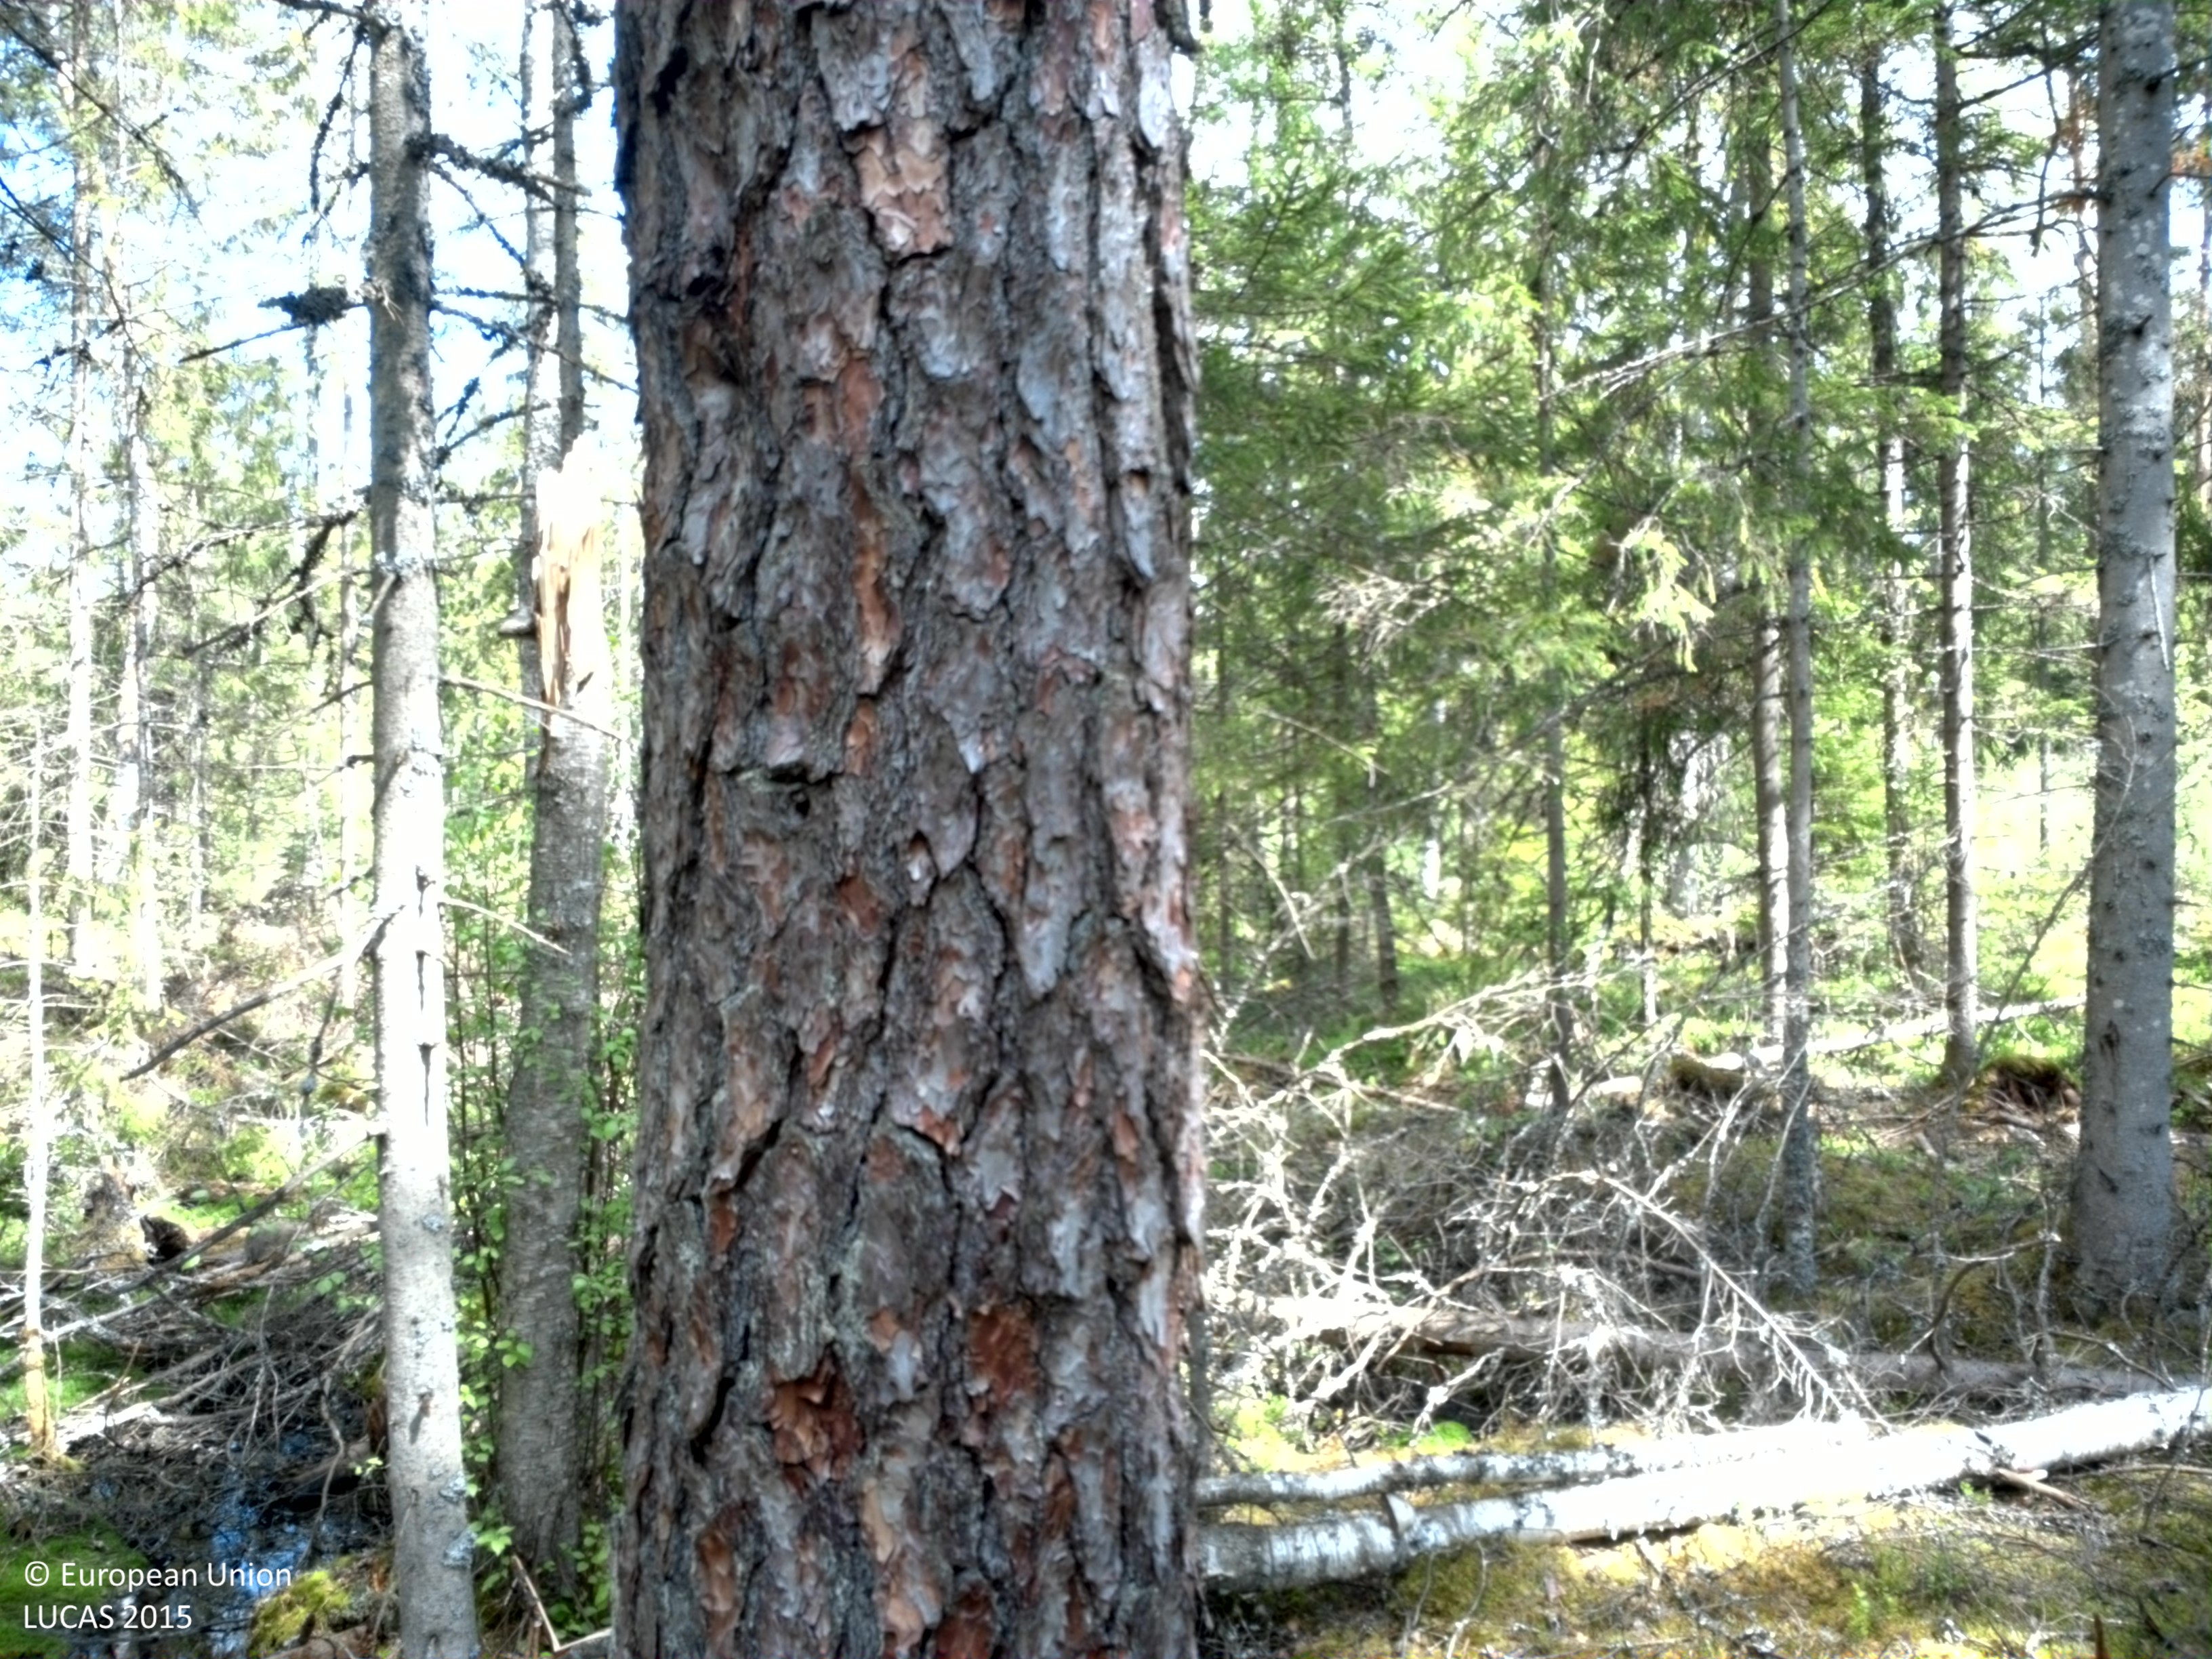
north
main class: Woodland
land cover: Pine dominated coniferous woodland
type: boreal forest
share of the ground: > 75 %
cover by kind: coniferous forest trees 60 %, broadleaved forest trees 20 %, shrubs 10 %, lichens and mosses 10 %
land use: Forestry
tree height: > 5 m
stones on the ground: < 10 %
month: May
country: SE
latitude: 56.5971
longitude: 14.4436
